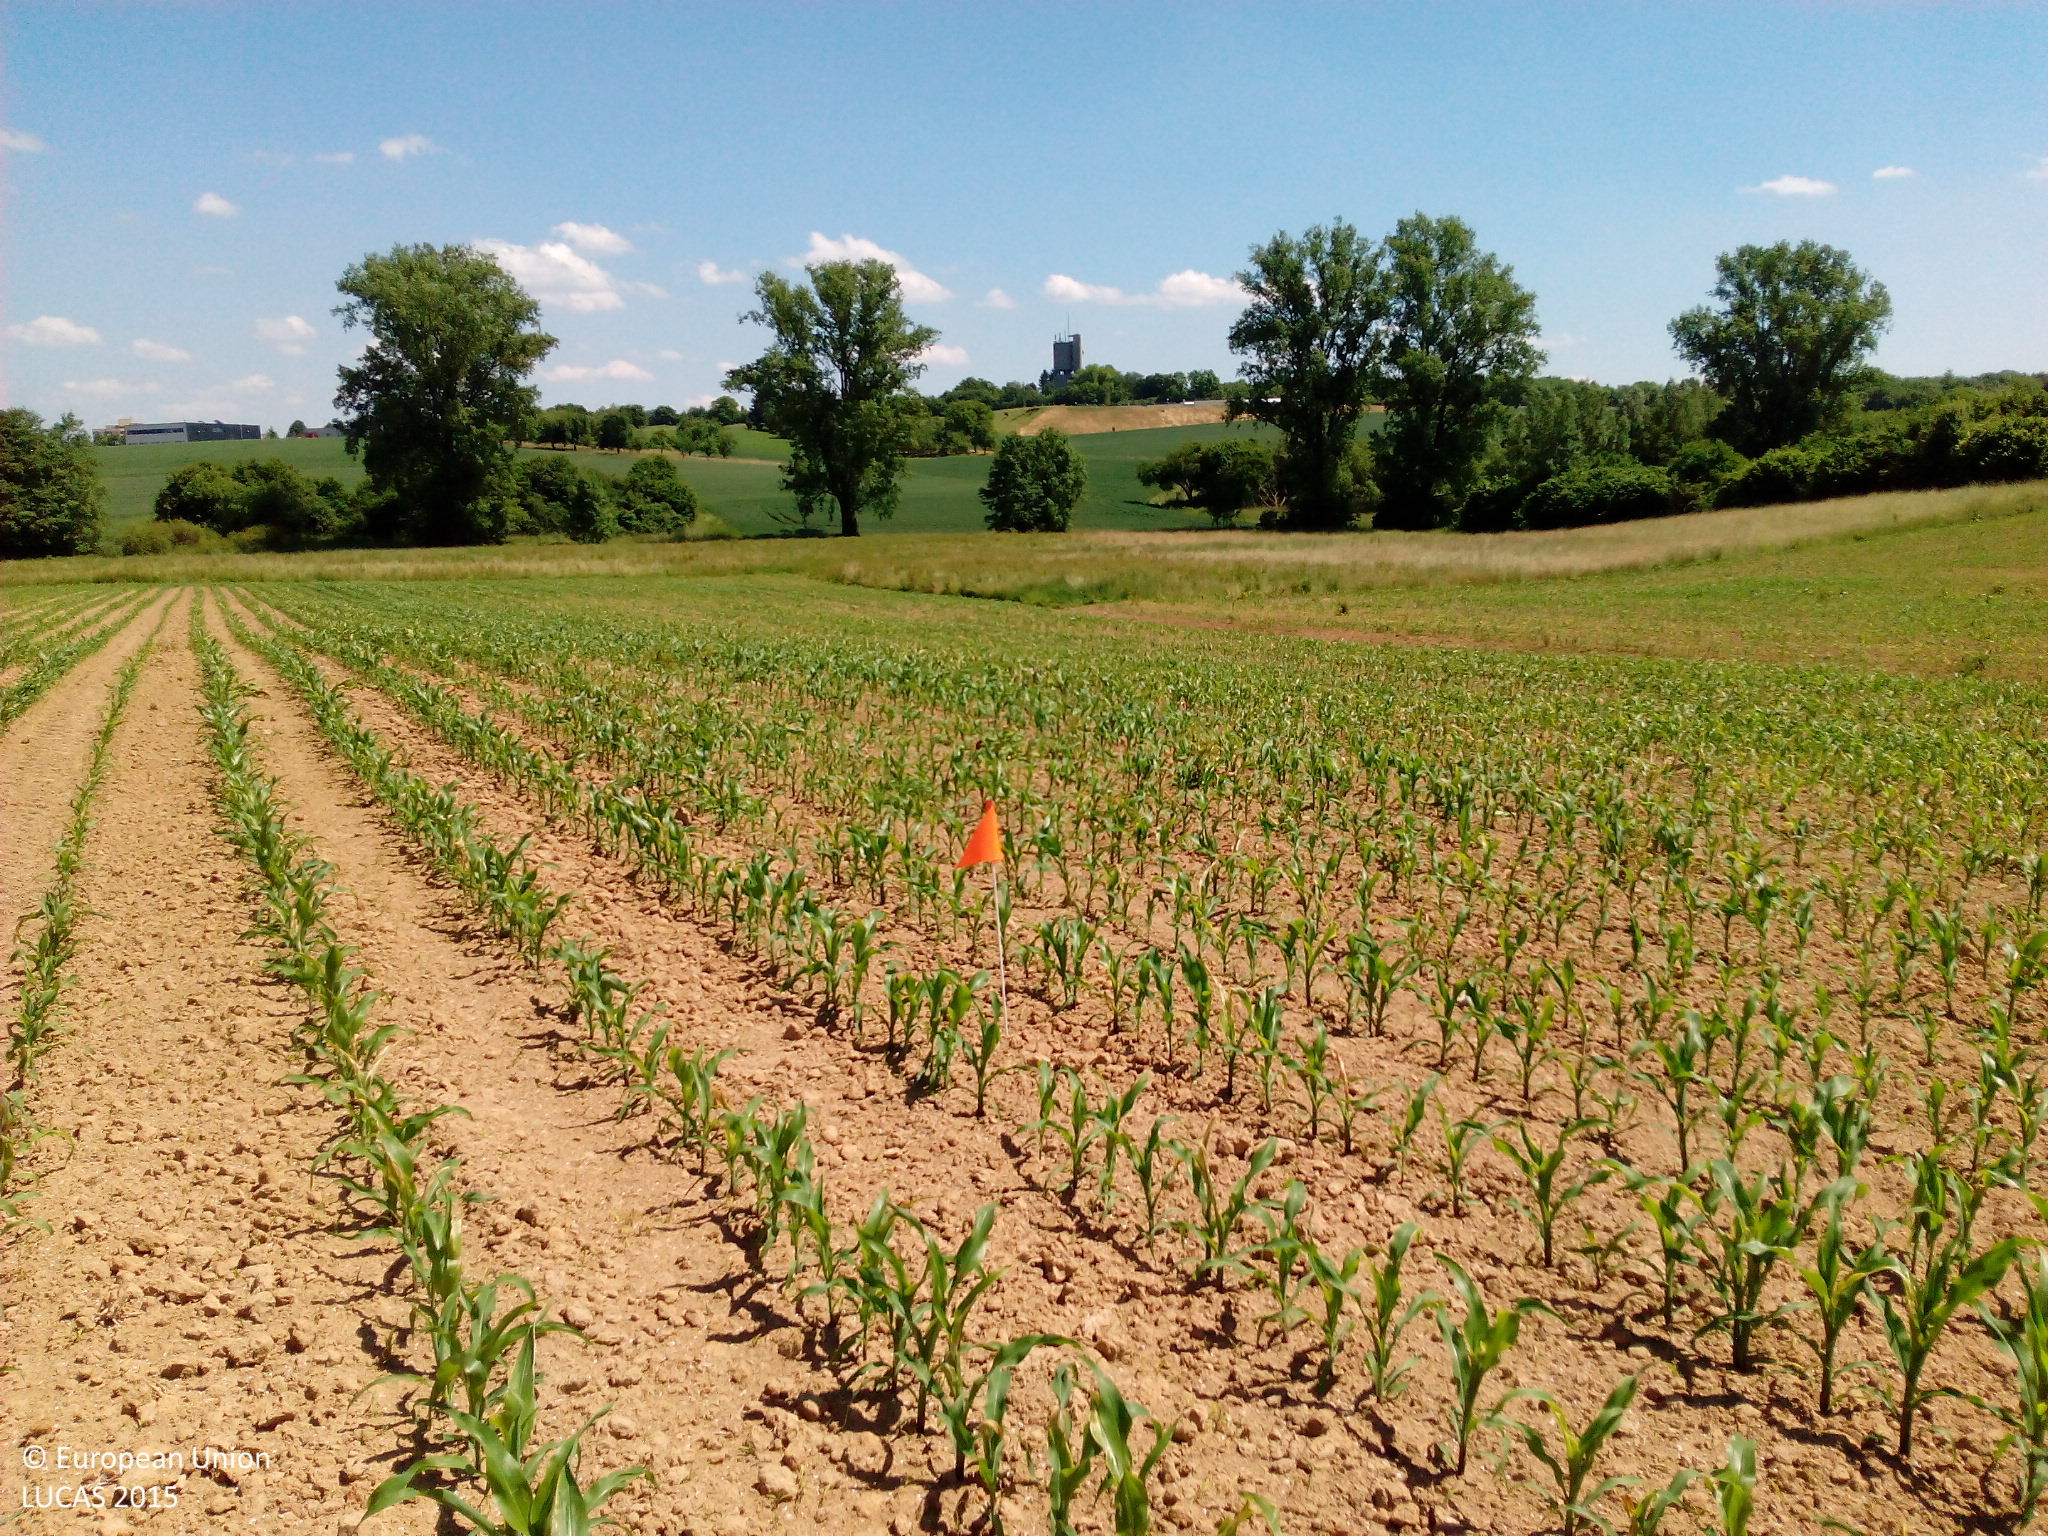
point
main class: Cropland
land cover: Maize
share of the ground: 10 - 25 %
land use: Agriculture (excluding fallow land and kitchen gardens)
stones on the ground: < 10 %
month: June
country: DE
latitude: 48.9597
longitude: 9.4130
